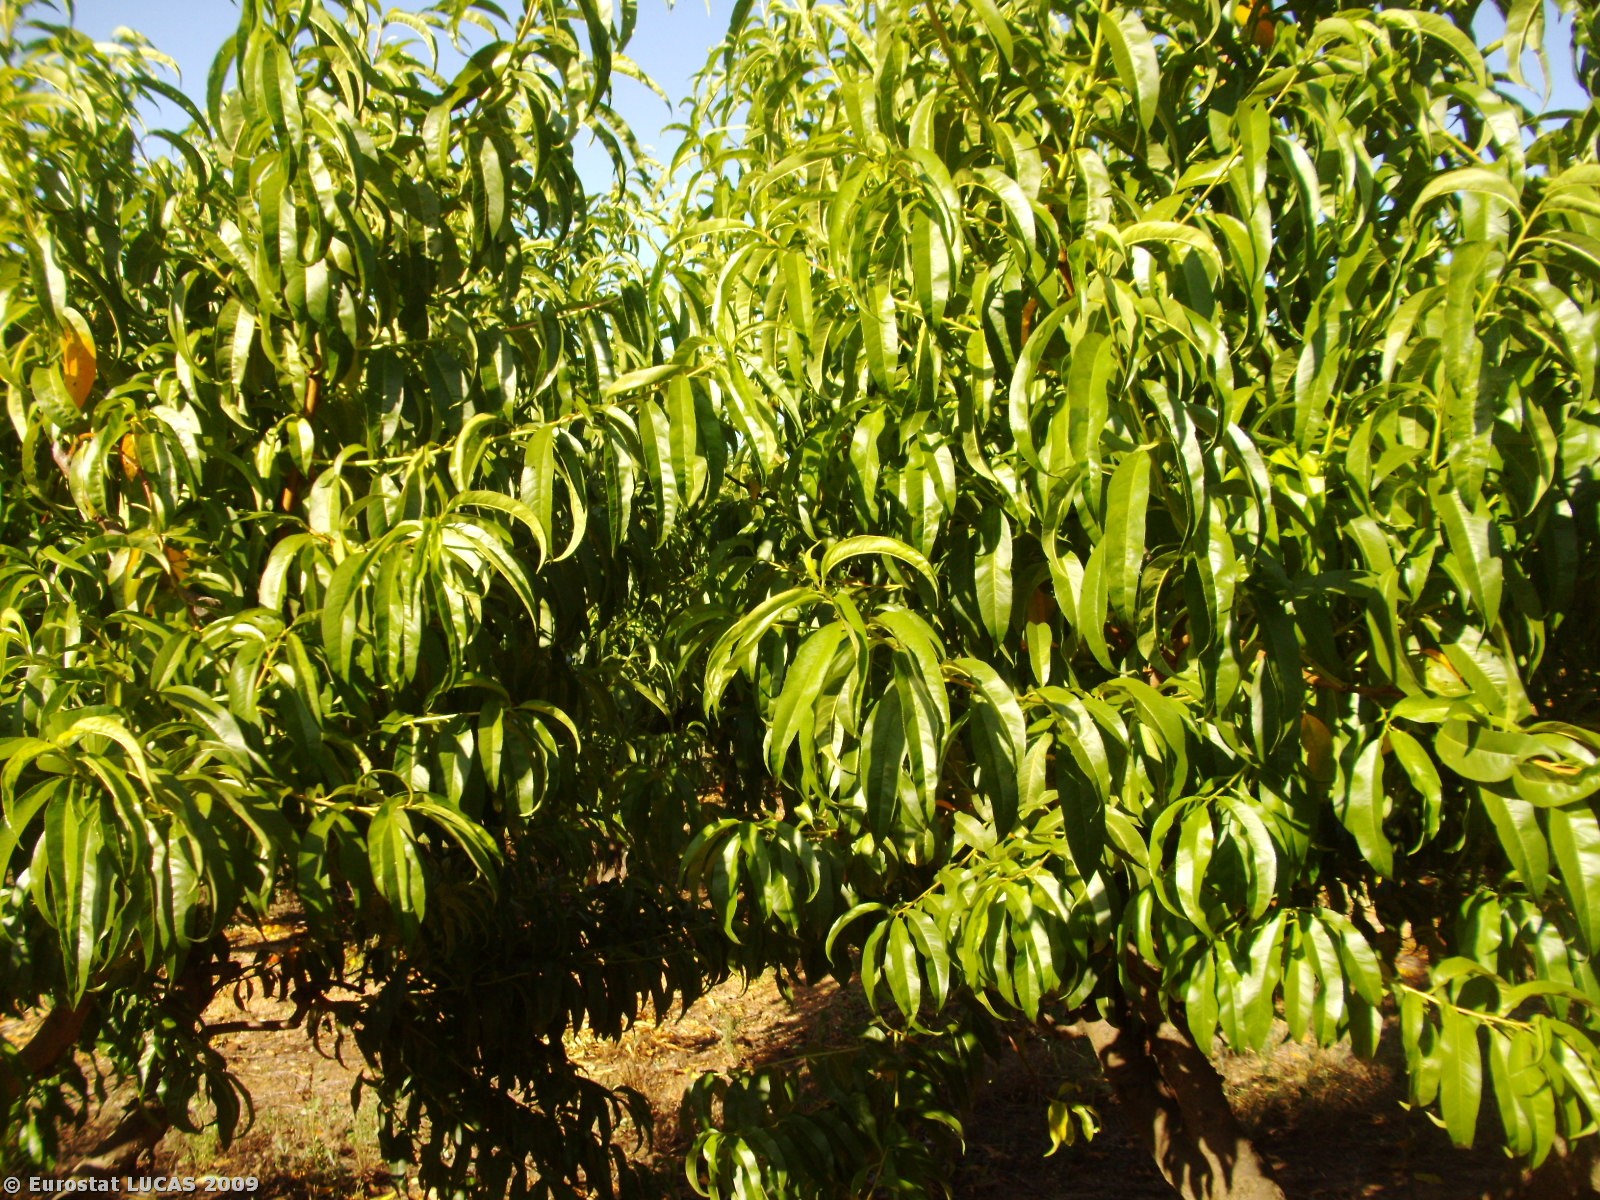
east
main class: Cropland
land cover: Other fruit trees and berries
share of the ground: > 75 %
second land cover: Spontaneously vegetated surfaces
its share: 10 - 25 %
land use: Agriculture (excluding fallow land and kitchen gardens)
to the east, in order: Other fruit trees and berries; Spontaneously vegetated surfaces; Other fruit trees and berries; Tracks; Other fruit trees and berries; Tracks; Other fruit trees and berries; Electric lines; Shruby margins; Cherry fruit; Tracks; Other fruit trees and berries; Electric lines; Other fruit trees and berries; Tracks
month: July
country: PT
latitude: 40.3415
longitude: -7.3990
